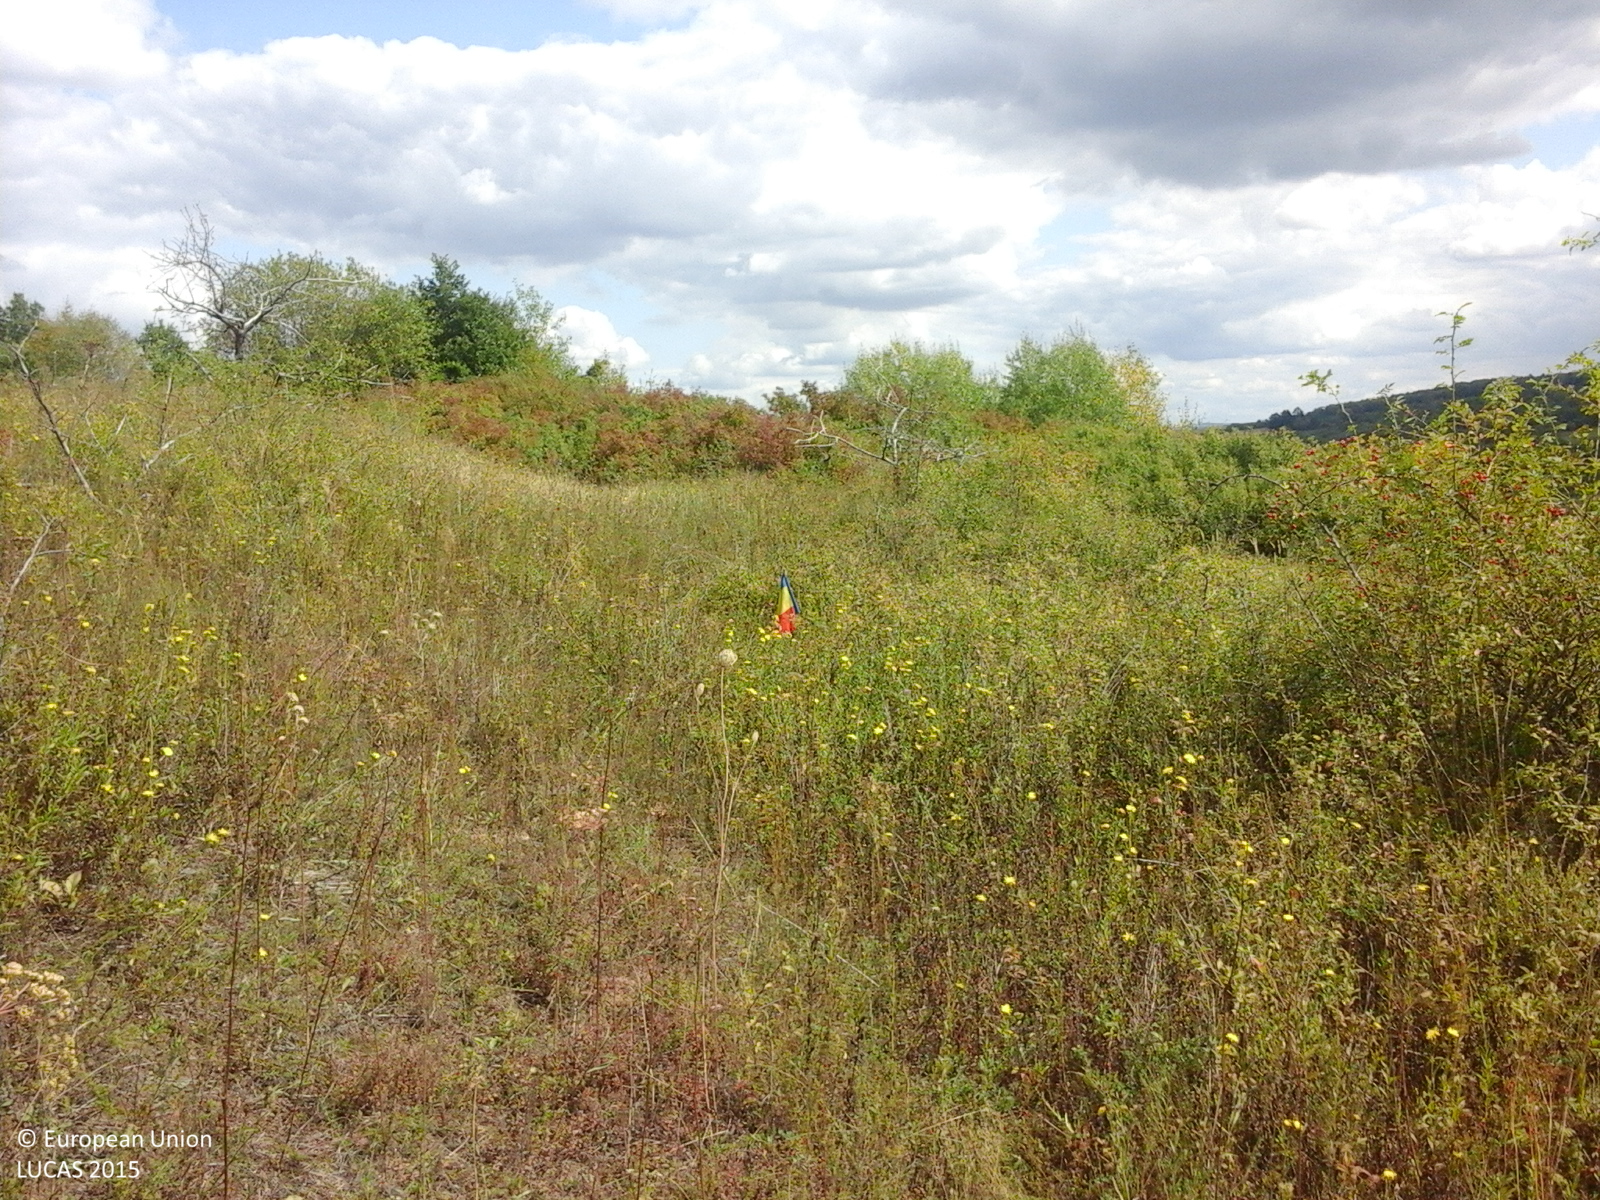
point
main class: Grassland
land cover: Spontaneously vegetated surfaces
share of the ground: > 75 %
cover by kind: herbaceous plants 100 %
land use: Fallow land
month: September
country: RO
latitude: 47.4585
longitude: 23.0789
